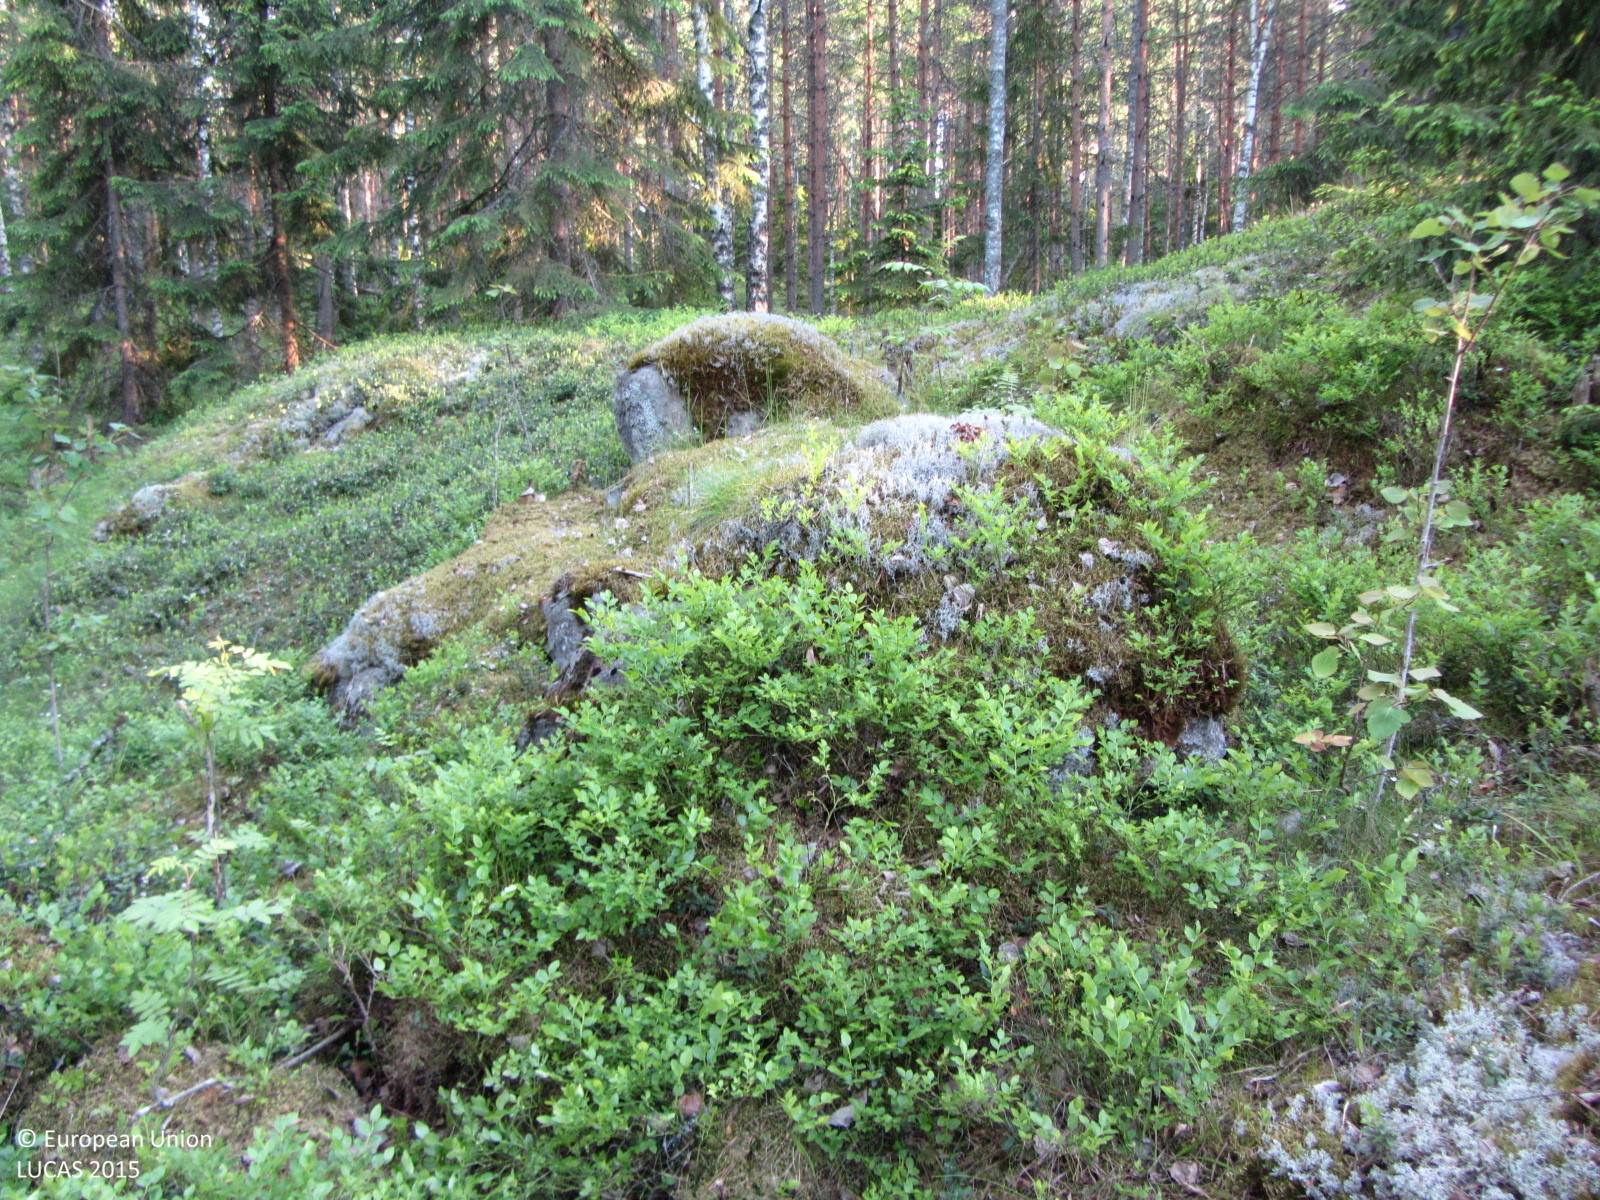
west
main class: Woodland
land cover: Other coniferous woodland
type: boreal forest
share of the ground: 50 - 75 %
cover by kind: coniferous forest trees 50 %, shrubs 30 %, broadleaved forest trees 10 %, lichens and mosses 10 %
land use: Forestry
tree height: > 5 m
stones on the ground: 10 - 25 %
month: June
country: FI
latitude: 60.3500
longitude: 24.2555
